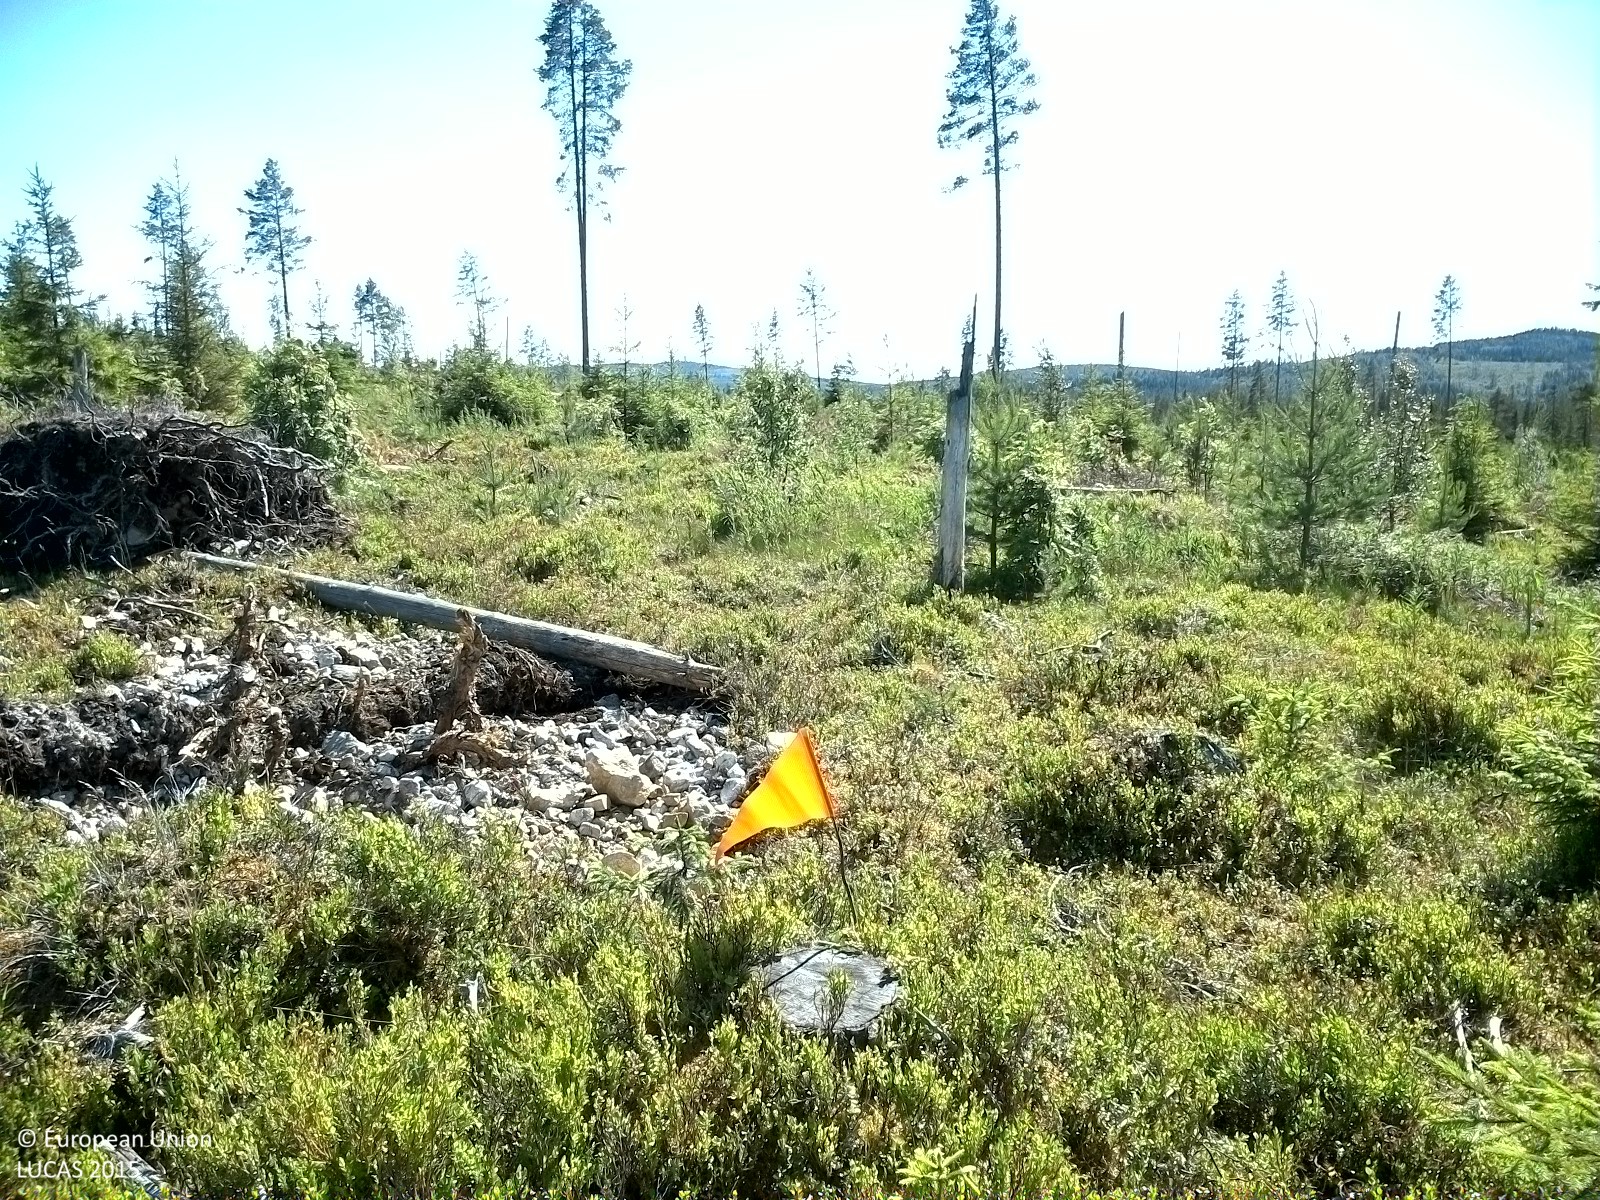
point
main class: Woodland
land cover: Spruce dominated coniferous woodland
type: boreal forest
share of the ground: 10 - 25 %
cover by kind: shrubs 70 %, coniferous forest trees 10 %, herbaceous plants 10 %, unconsolidated bare surface 10 %
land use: Forestry
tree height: < 5 m
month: July
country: SE
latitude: 62.2374
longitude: 16.8893
